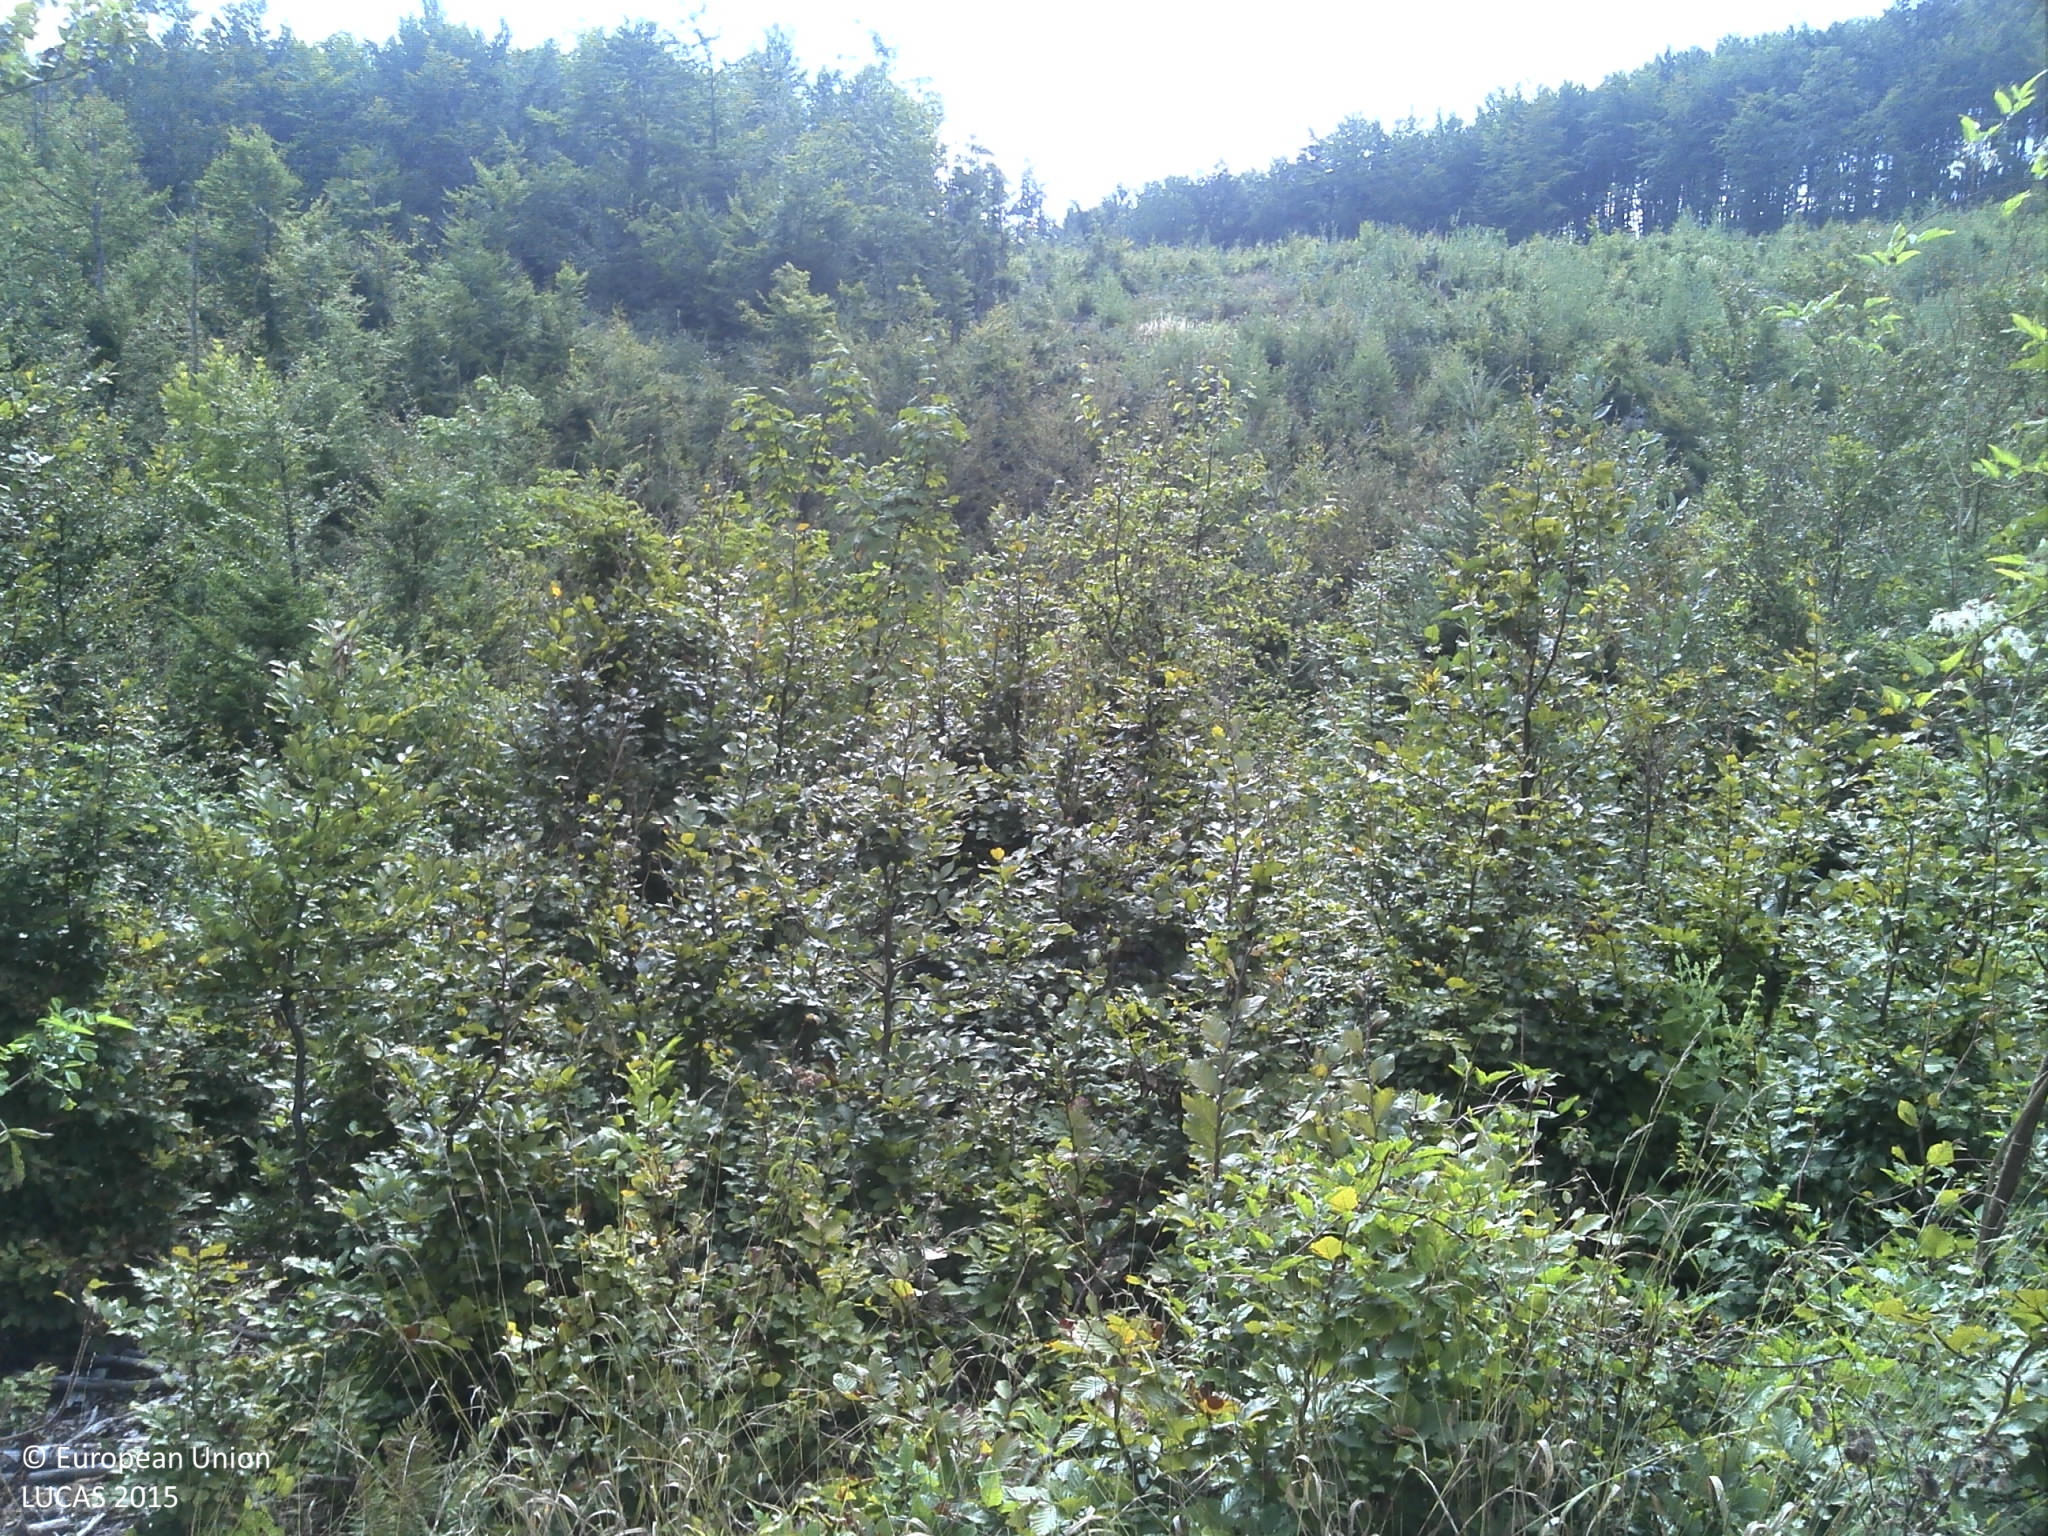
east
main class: Woodland
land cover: Broadleaved woodland
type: beech forest
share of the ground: > 75 %
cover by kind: broadleaved forest trees 100 %
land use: Forestry
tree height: > 5 m
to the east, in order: Broadleaved woodland; Shrubland with sparse tree cover; Broadleaved woodland
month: September
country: HR
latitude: 45.3215
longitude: 15.2132
